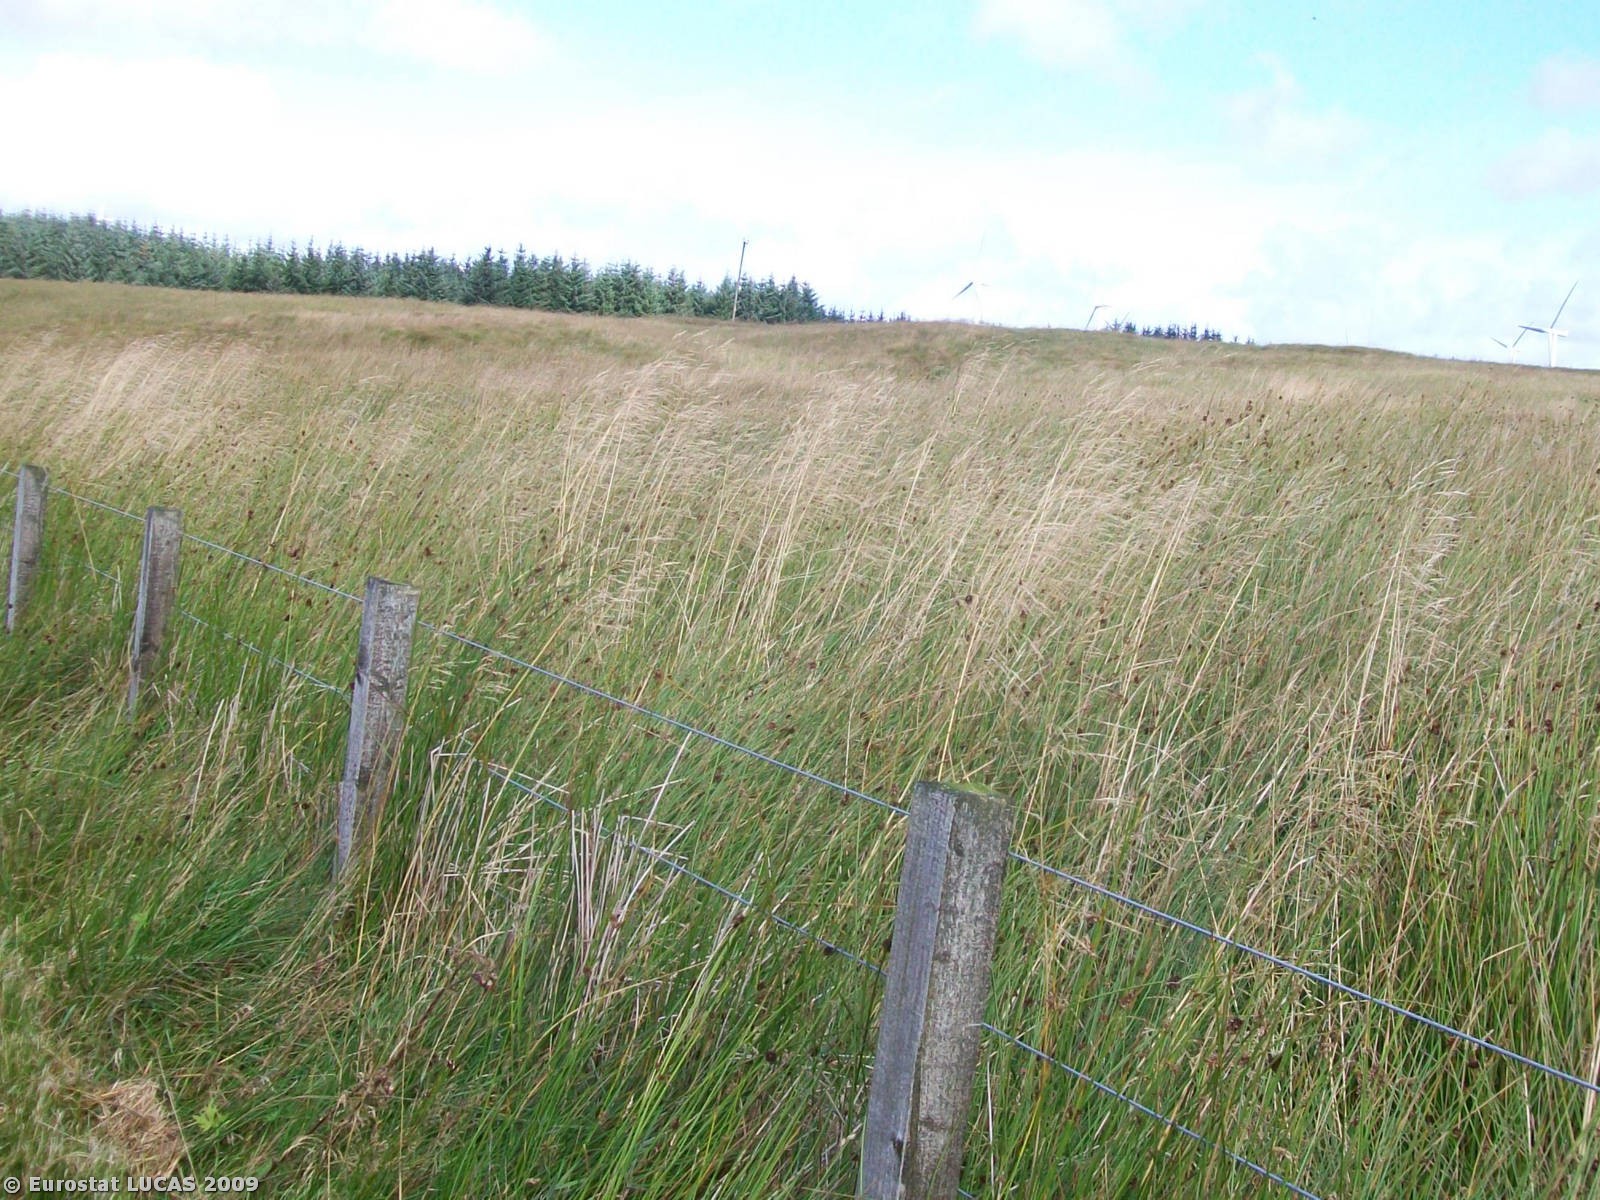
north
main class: Grassland
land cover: Grassland without tree/shrub cover
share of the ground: 10 - 25 %
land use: Agriculture (excluding fallow land and kitchen gardens)
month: September
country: GB
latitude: 55.6674
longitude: -4.1945
